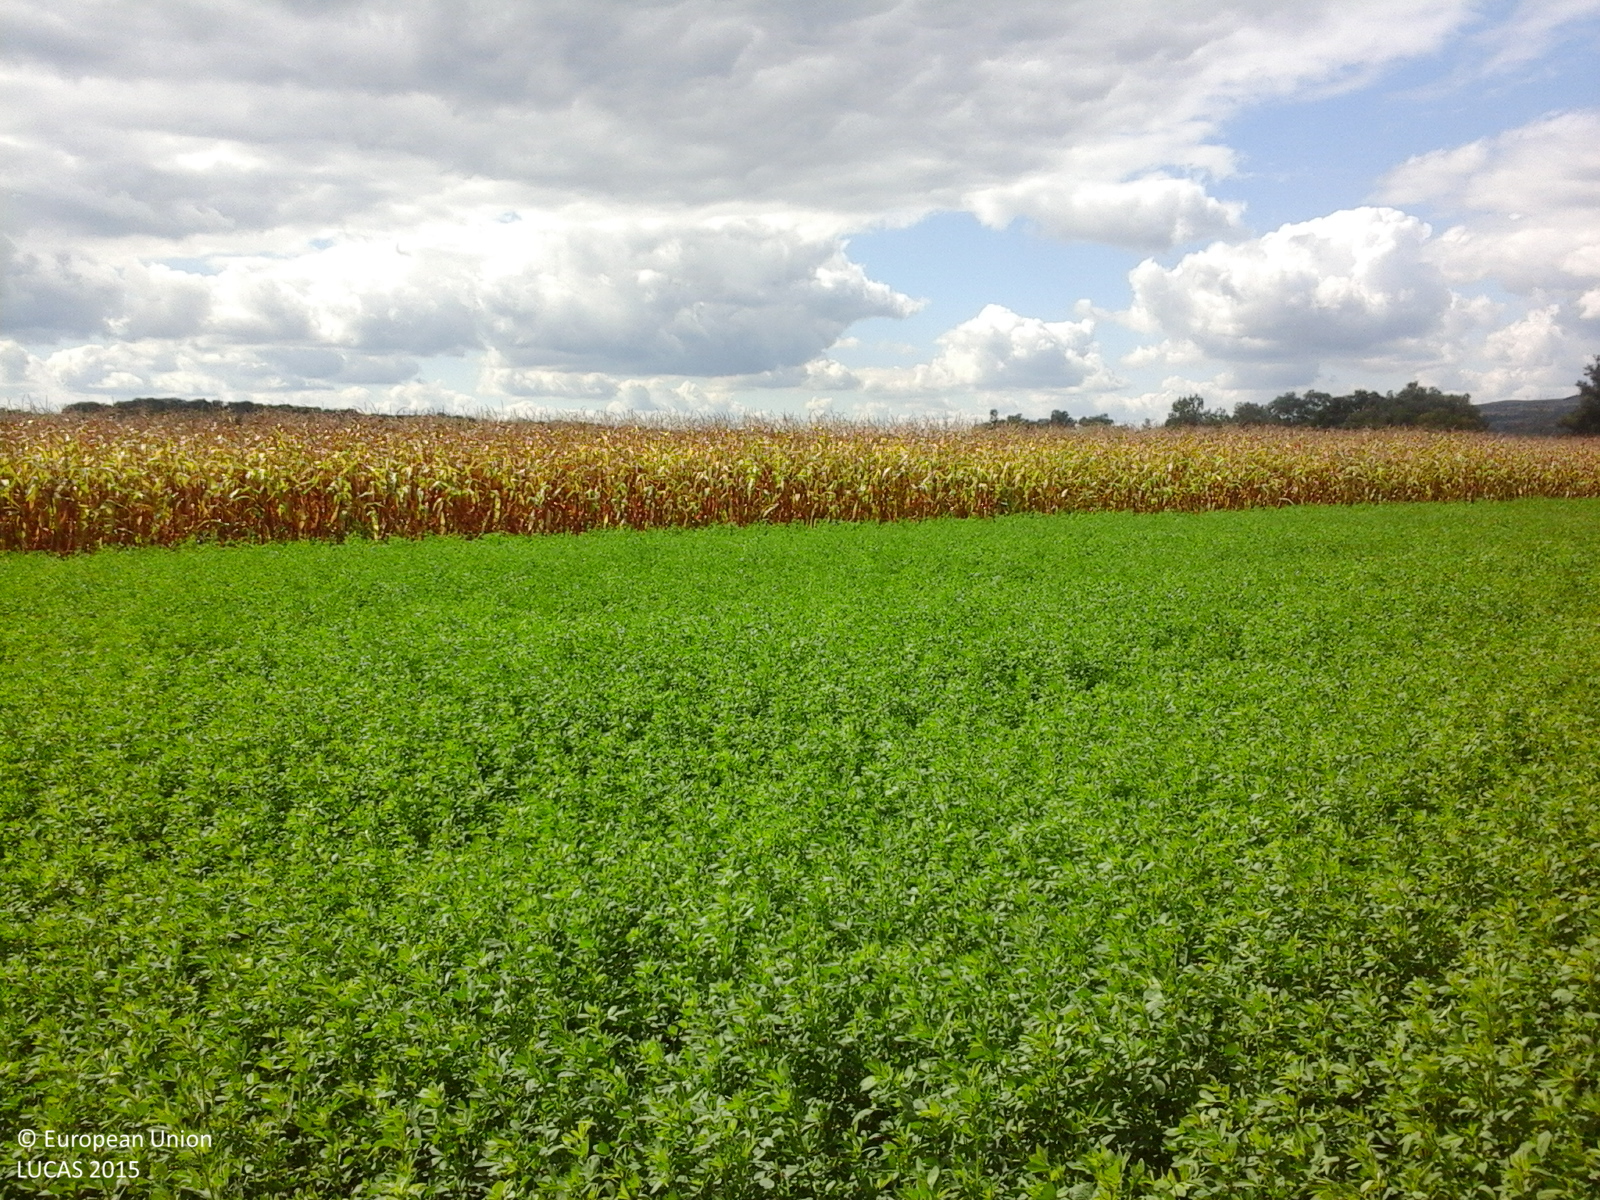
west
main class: Cropland
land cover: Maize
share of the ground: > 75 %
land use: Agriculture (excluding fallow land and kitchen gardens)
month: September
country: RO
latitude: 47.3220
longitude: 23.4480
